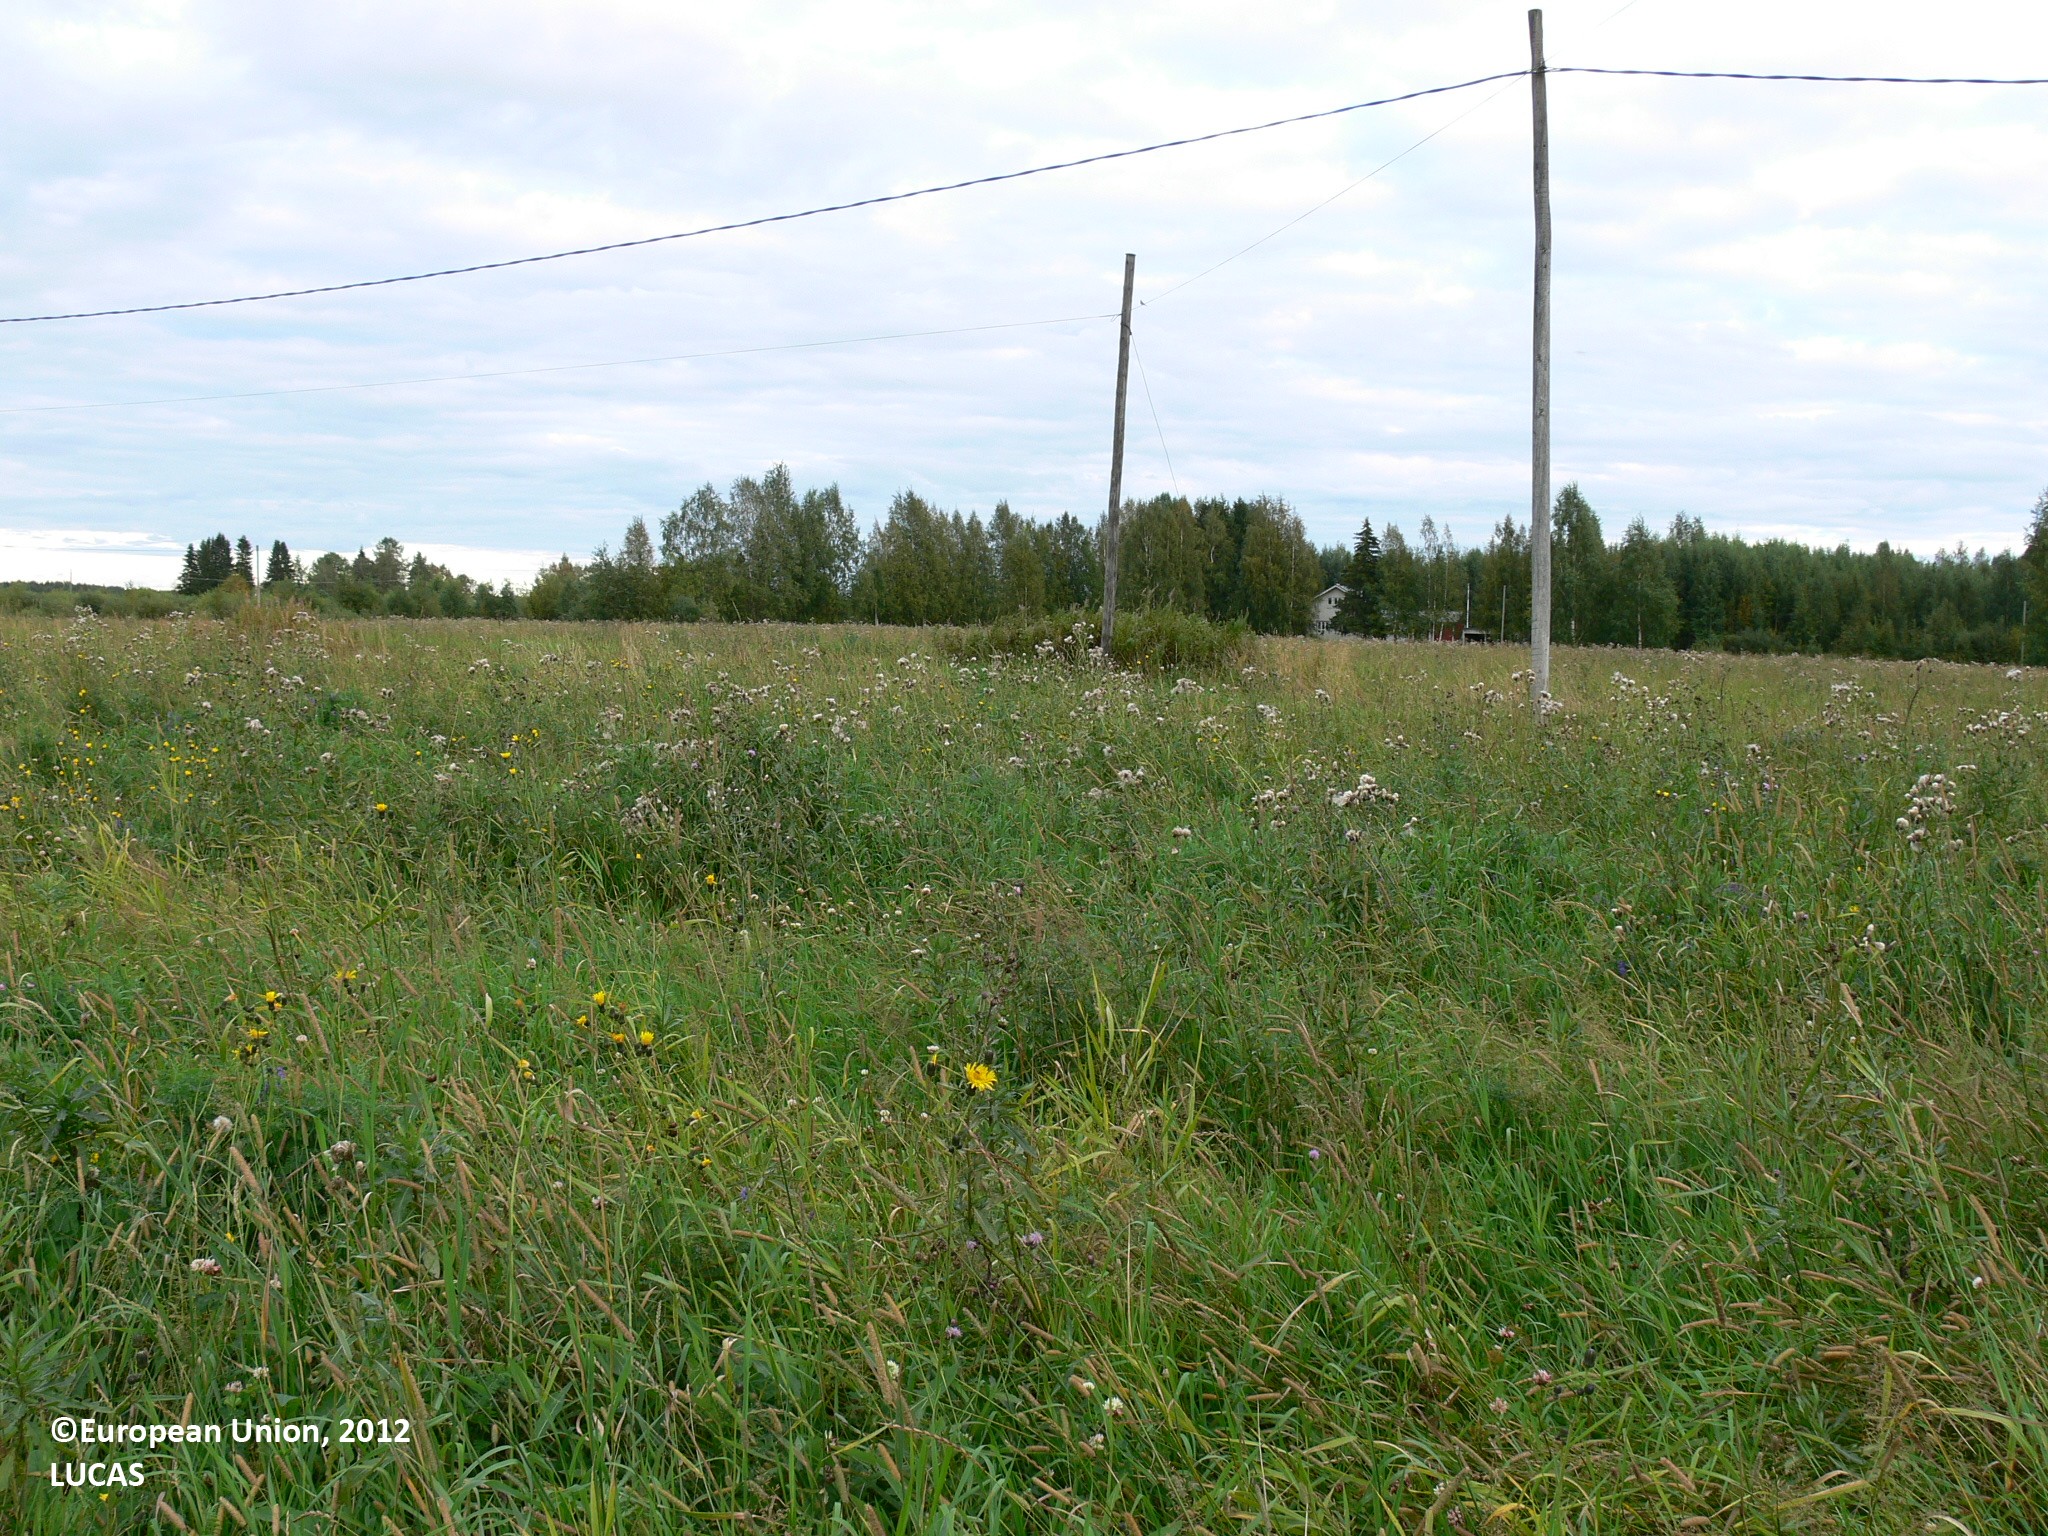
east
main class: Grassland
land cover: Spontaneously vegetated surfaces
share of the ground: > 75 %
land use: Fallow land
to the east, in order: Spontaneously vegetated surfaces; Ditches and canals; Spontaneously vegetated surfaces; Electric lines; Grass margins; Paved roads, cycling and walking lanes; Grass margins; Electric lines; Spontaneously vegetated surfaces; Ditches and canals; Spontaneously vegetated surfaces; Ditches and canals; Spontaneously vegetated surfaces; Ditches and canals; Spontaneously vegetated surfaces; Ditches and canals; Grass margins; Ditches and canals; Shrubland with sparse tree cover; Grass margins; Spontaneously vegetated surfaces; Paved roads, cycling and walking lanes; Grass margins; Ditches and canals; Spontaneously vegetated surfaces; Ditches and canals; Spontaneously vegetated surfaces; Ditches and canals; Spontaneously vegetated surfaces
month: August
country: FI
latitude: 63.3220
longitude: 30.0358
